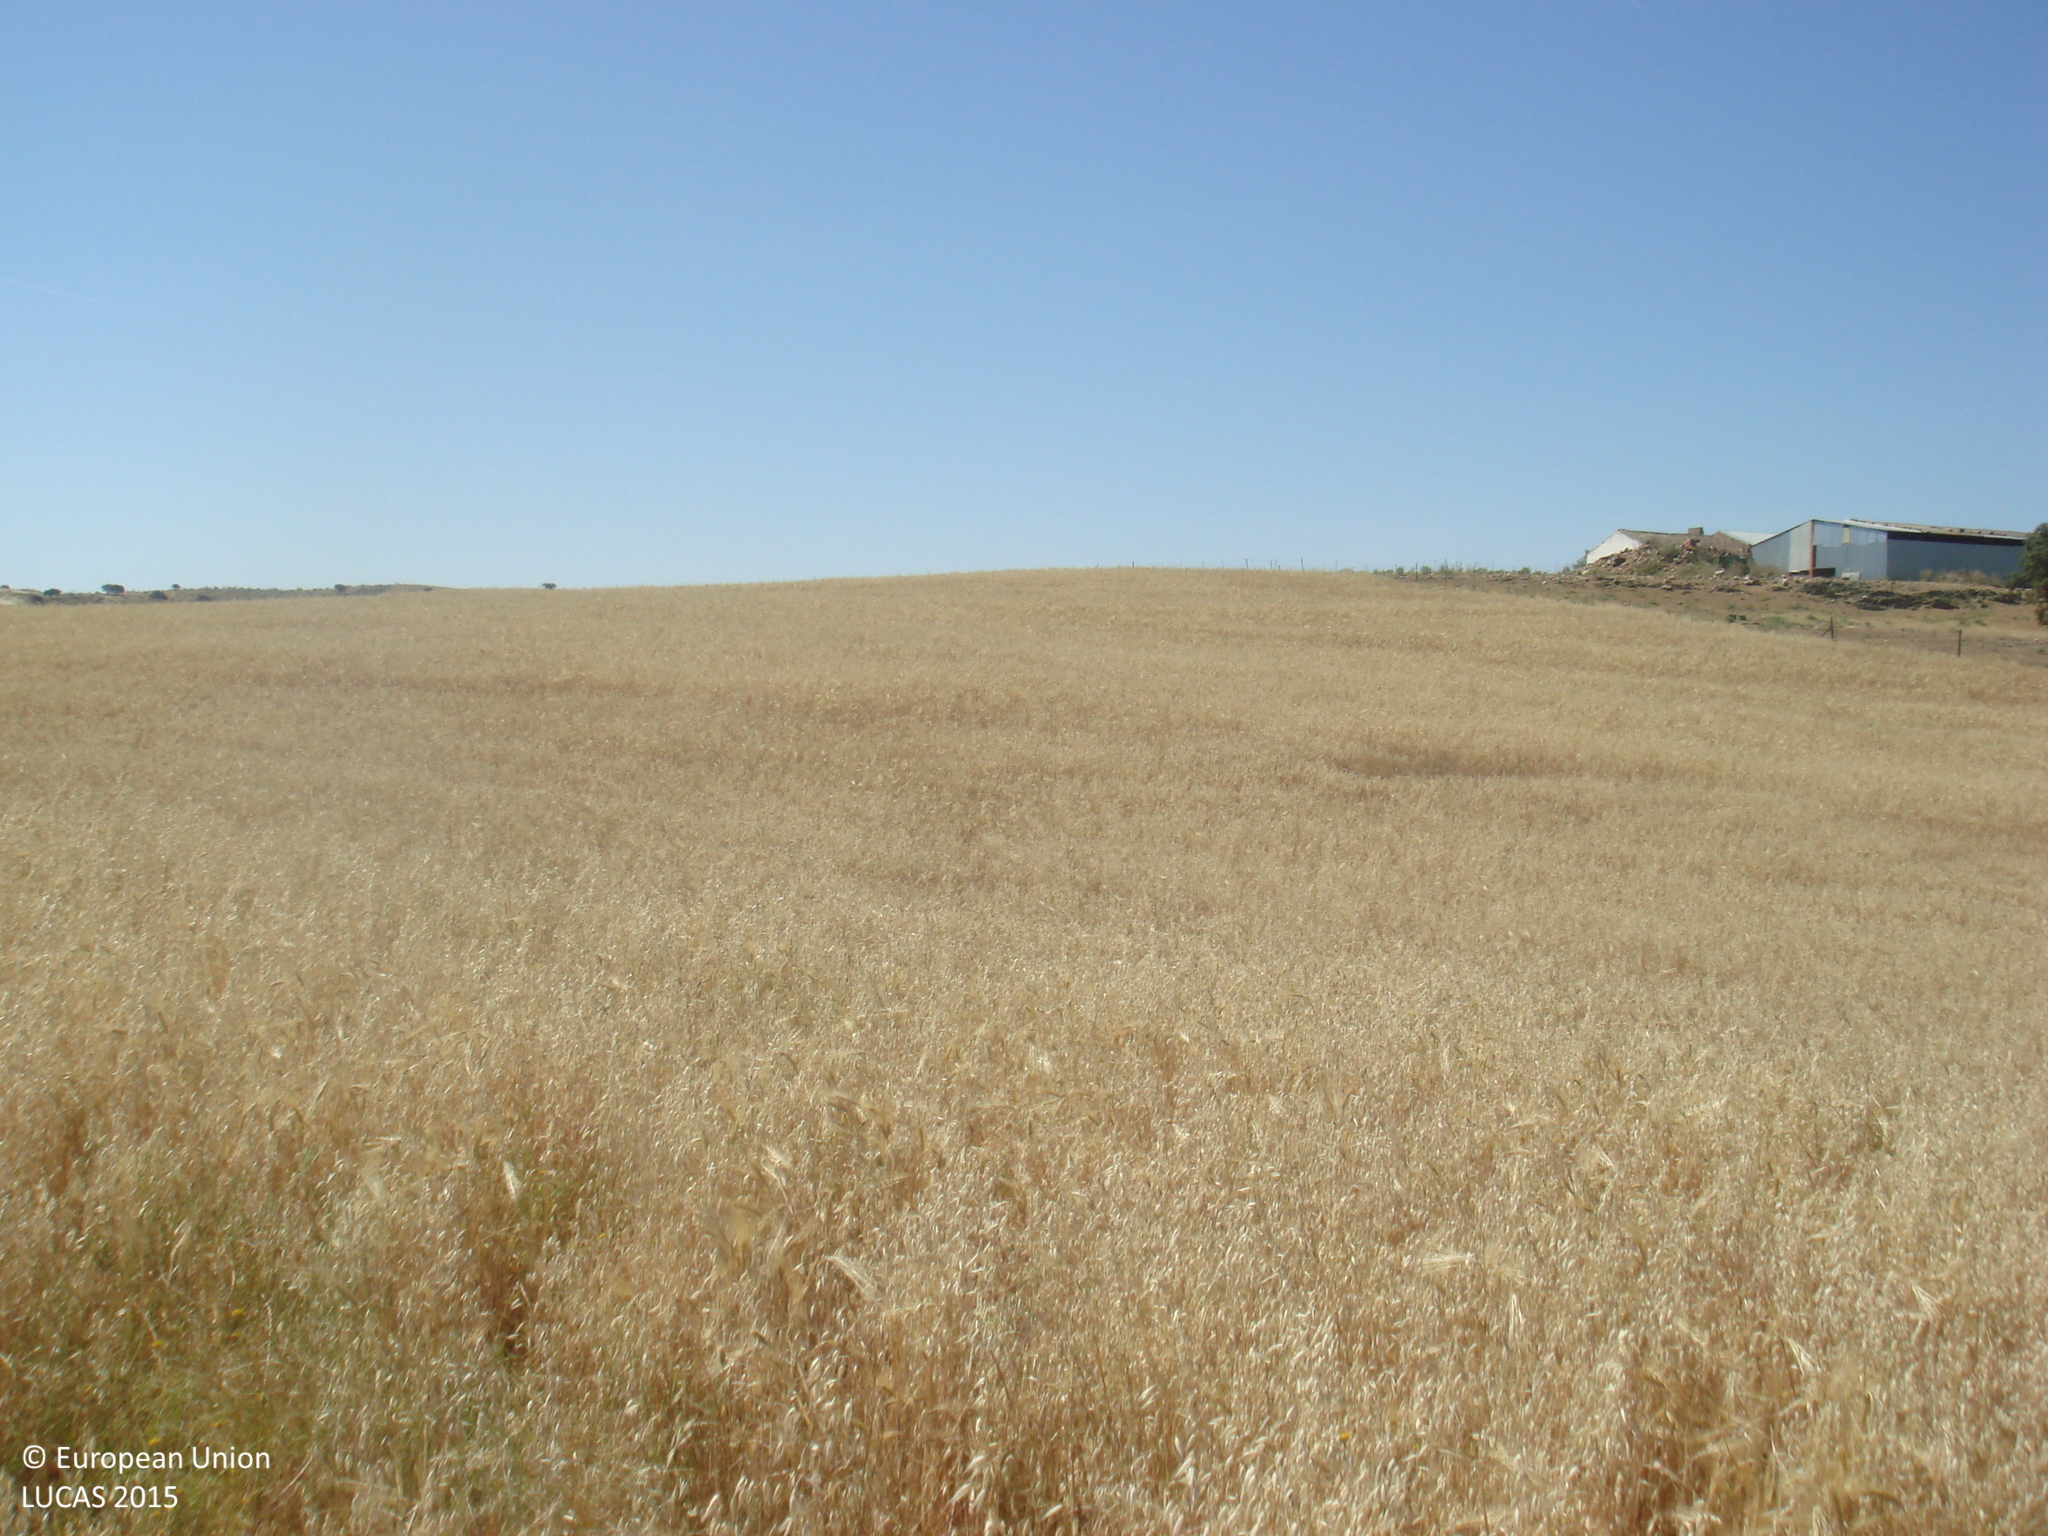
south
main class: Cropland
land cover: Mixed cereals for fodder
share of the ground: > 75 %
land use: Agriculture (excluding fallow land and kitchen gardens)
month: May
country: ES
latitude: 38.6755
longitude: -5.1711
